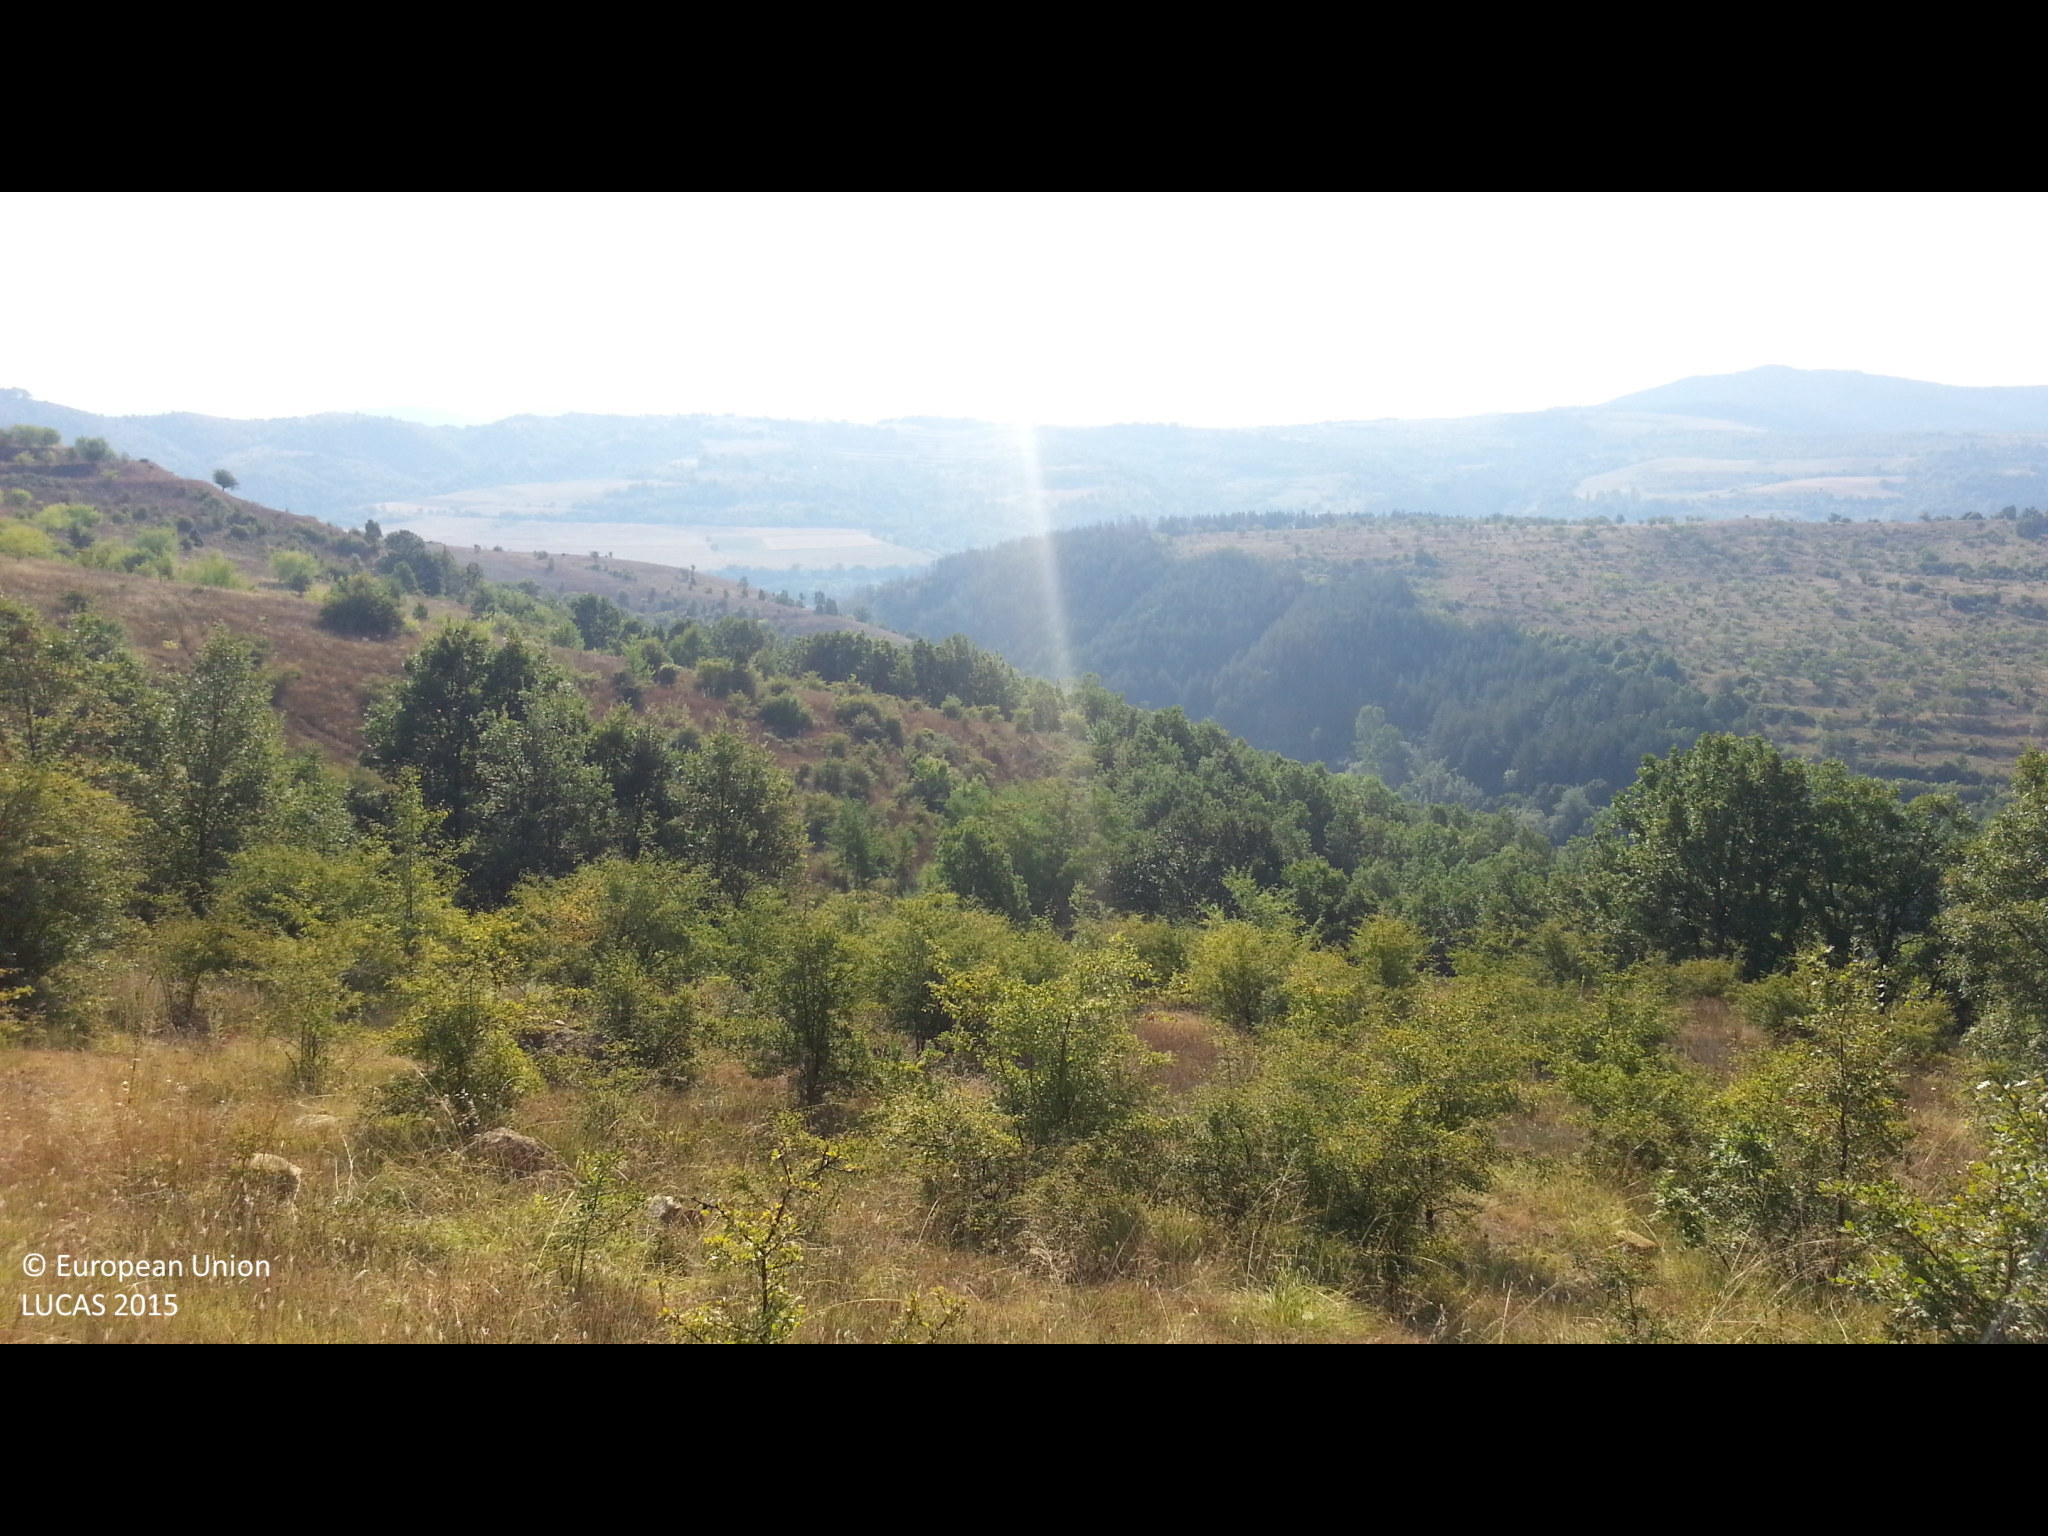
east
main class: Grassland
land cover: Grassland with sparse tree/shrub cover
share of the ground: > 75 %
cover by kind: herbaceous plants 95 %, coniferous forest trees 5 %
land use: Forestry
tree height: > 5 m
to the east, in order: Grassland with sparse tree/shrub cover; Shrubland with sparse tree cover; Grassland with sparse tree/shrub cover; Tracks; Grassland with sparse tree/shrub cover; Broadleaved woodland; Grassland with sparse tree/shrub cover
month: August
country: BG
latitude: 42.2151
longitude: 22.8515
